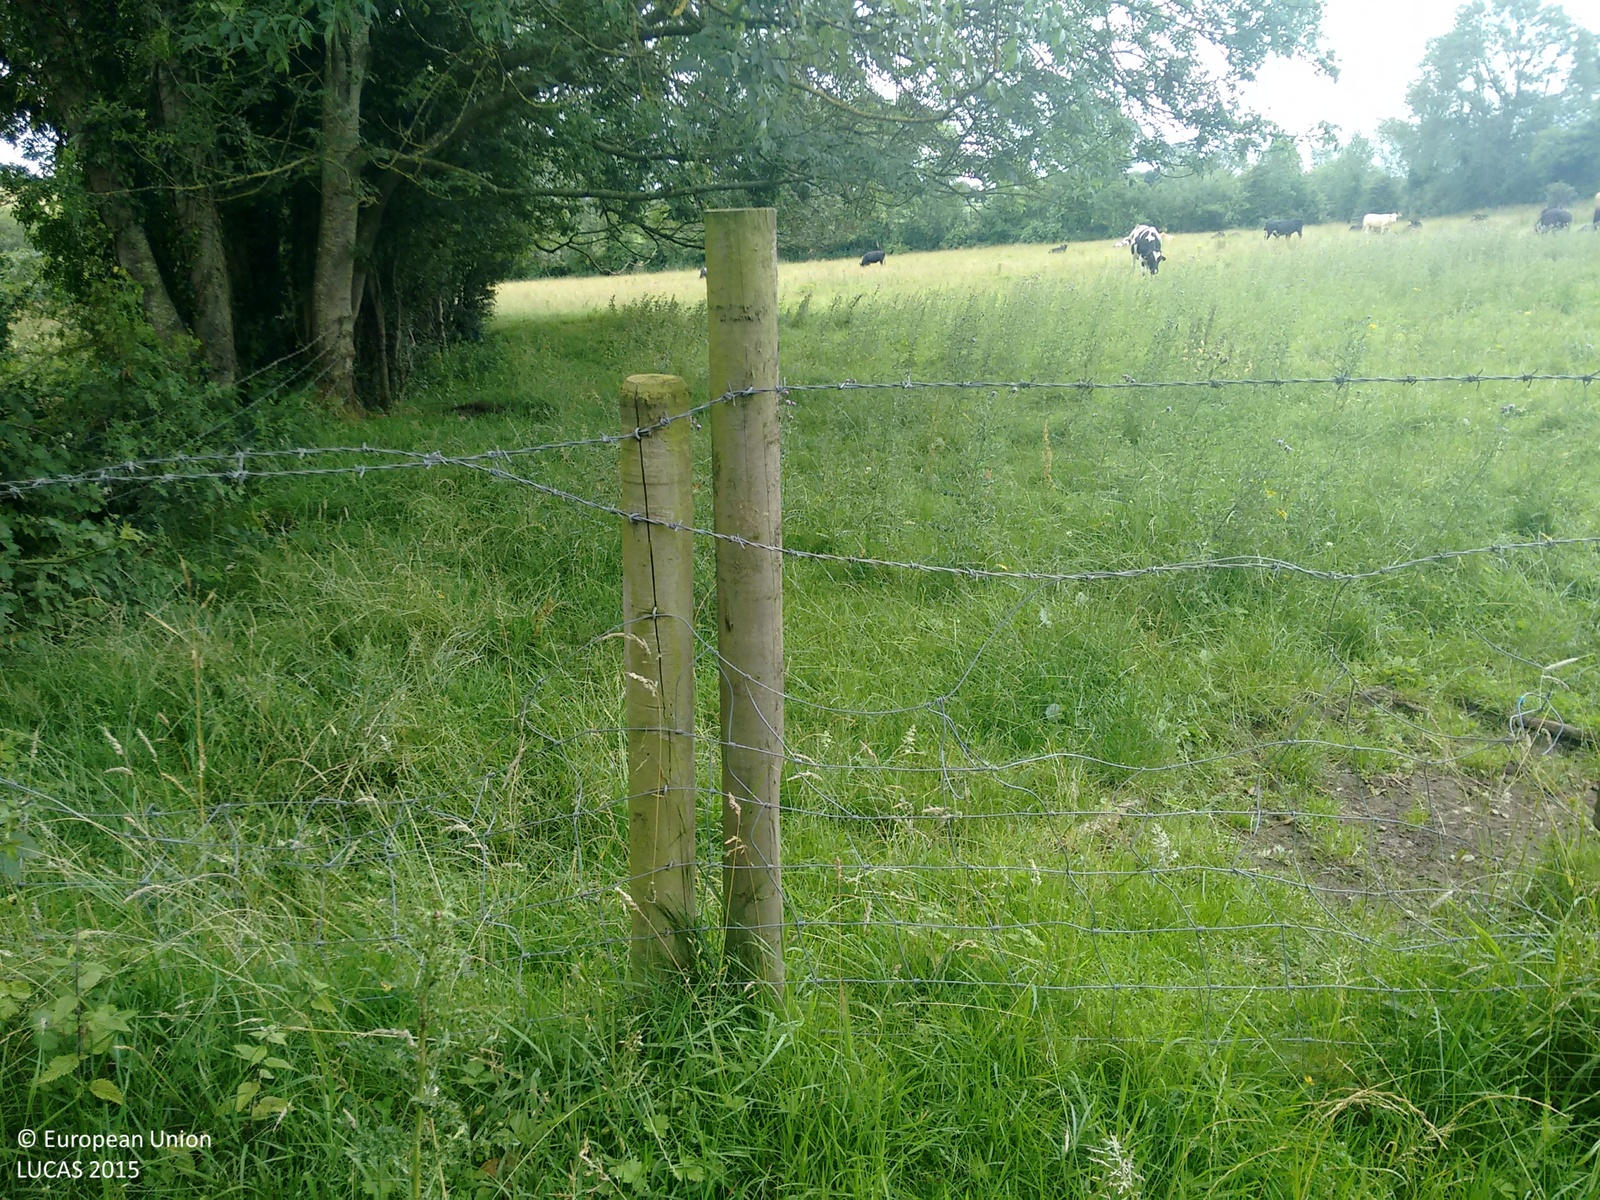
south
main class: Grassland
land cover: Grassland without tree/shrub cover
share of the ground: > 75 %
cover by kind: herbaceous plants 100 %
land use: Agriculture (excluding fallow land and kitchen gardens)
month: August
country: GB
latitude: 54.3197
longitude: -6.7514
